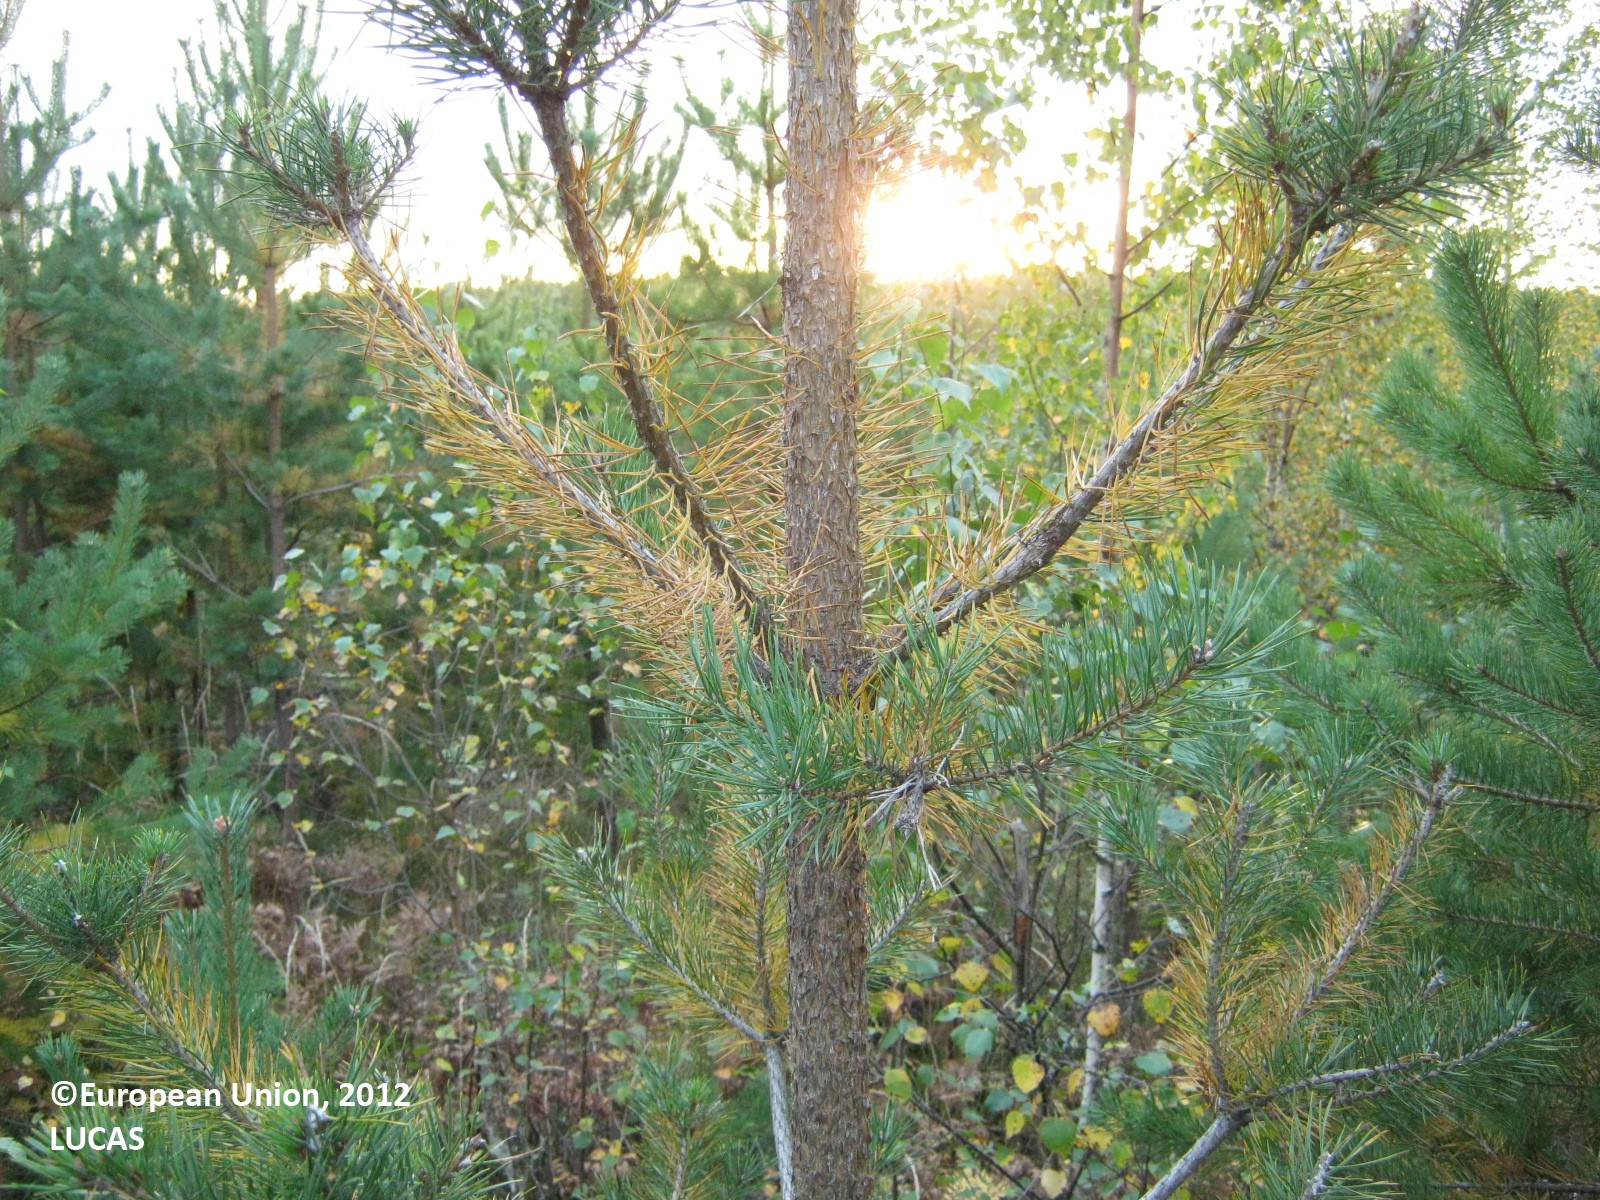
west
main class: Woodland
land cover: Pine dominated coniferous woodland
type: boreal forest
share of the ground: > 75 %
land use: Forestry
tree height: < 5 m
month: September
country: FI
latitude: 60.8488
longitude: 27.9583
